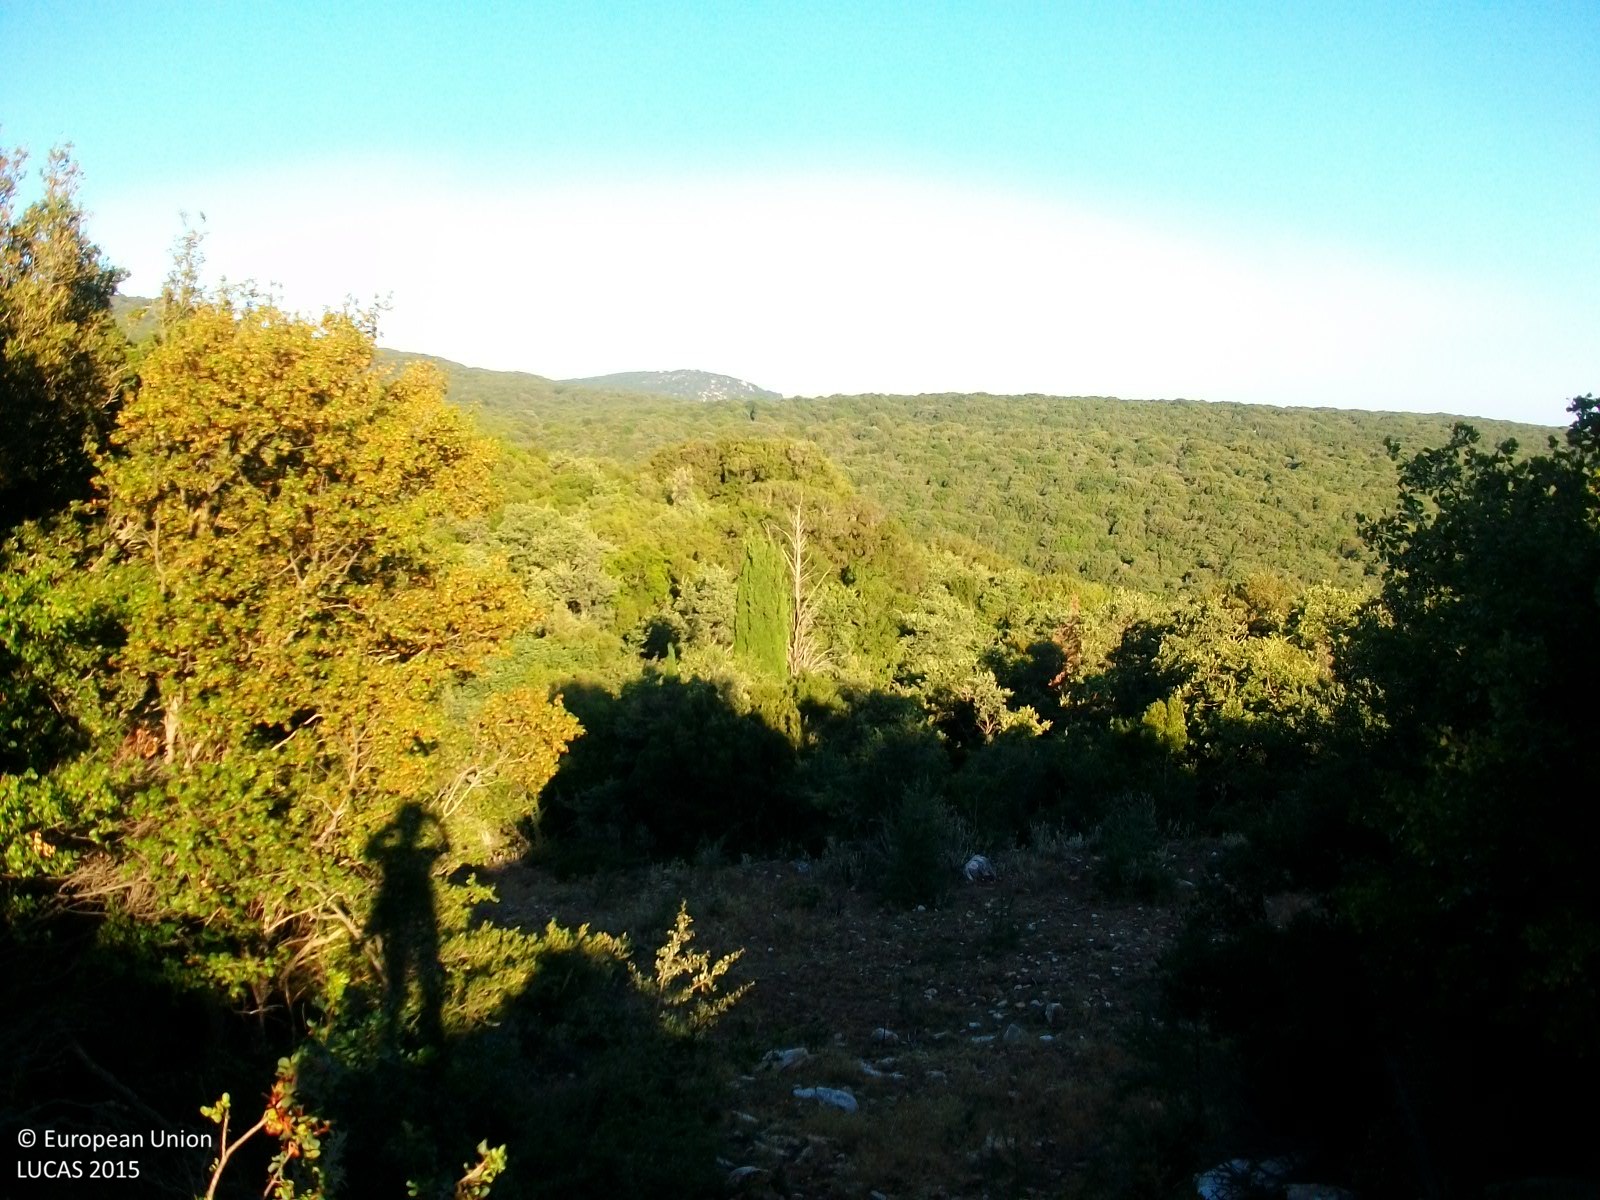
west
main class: Woodland
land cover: Broadleaved woodland
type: broadleaved evergreen forest
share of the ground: > 75 %
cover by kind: broadleaved forest trees 100 %
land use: Semi-natural and natural areas not in use
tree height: > 5 m
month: July
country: GR
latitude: 36.9469
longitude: 21.8652
